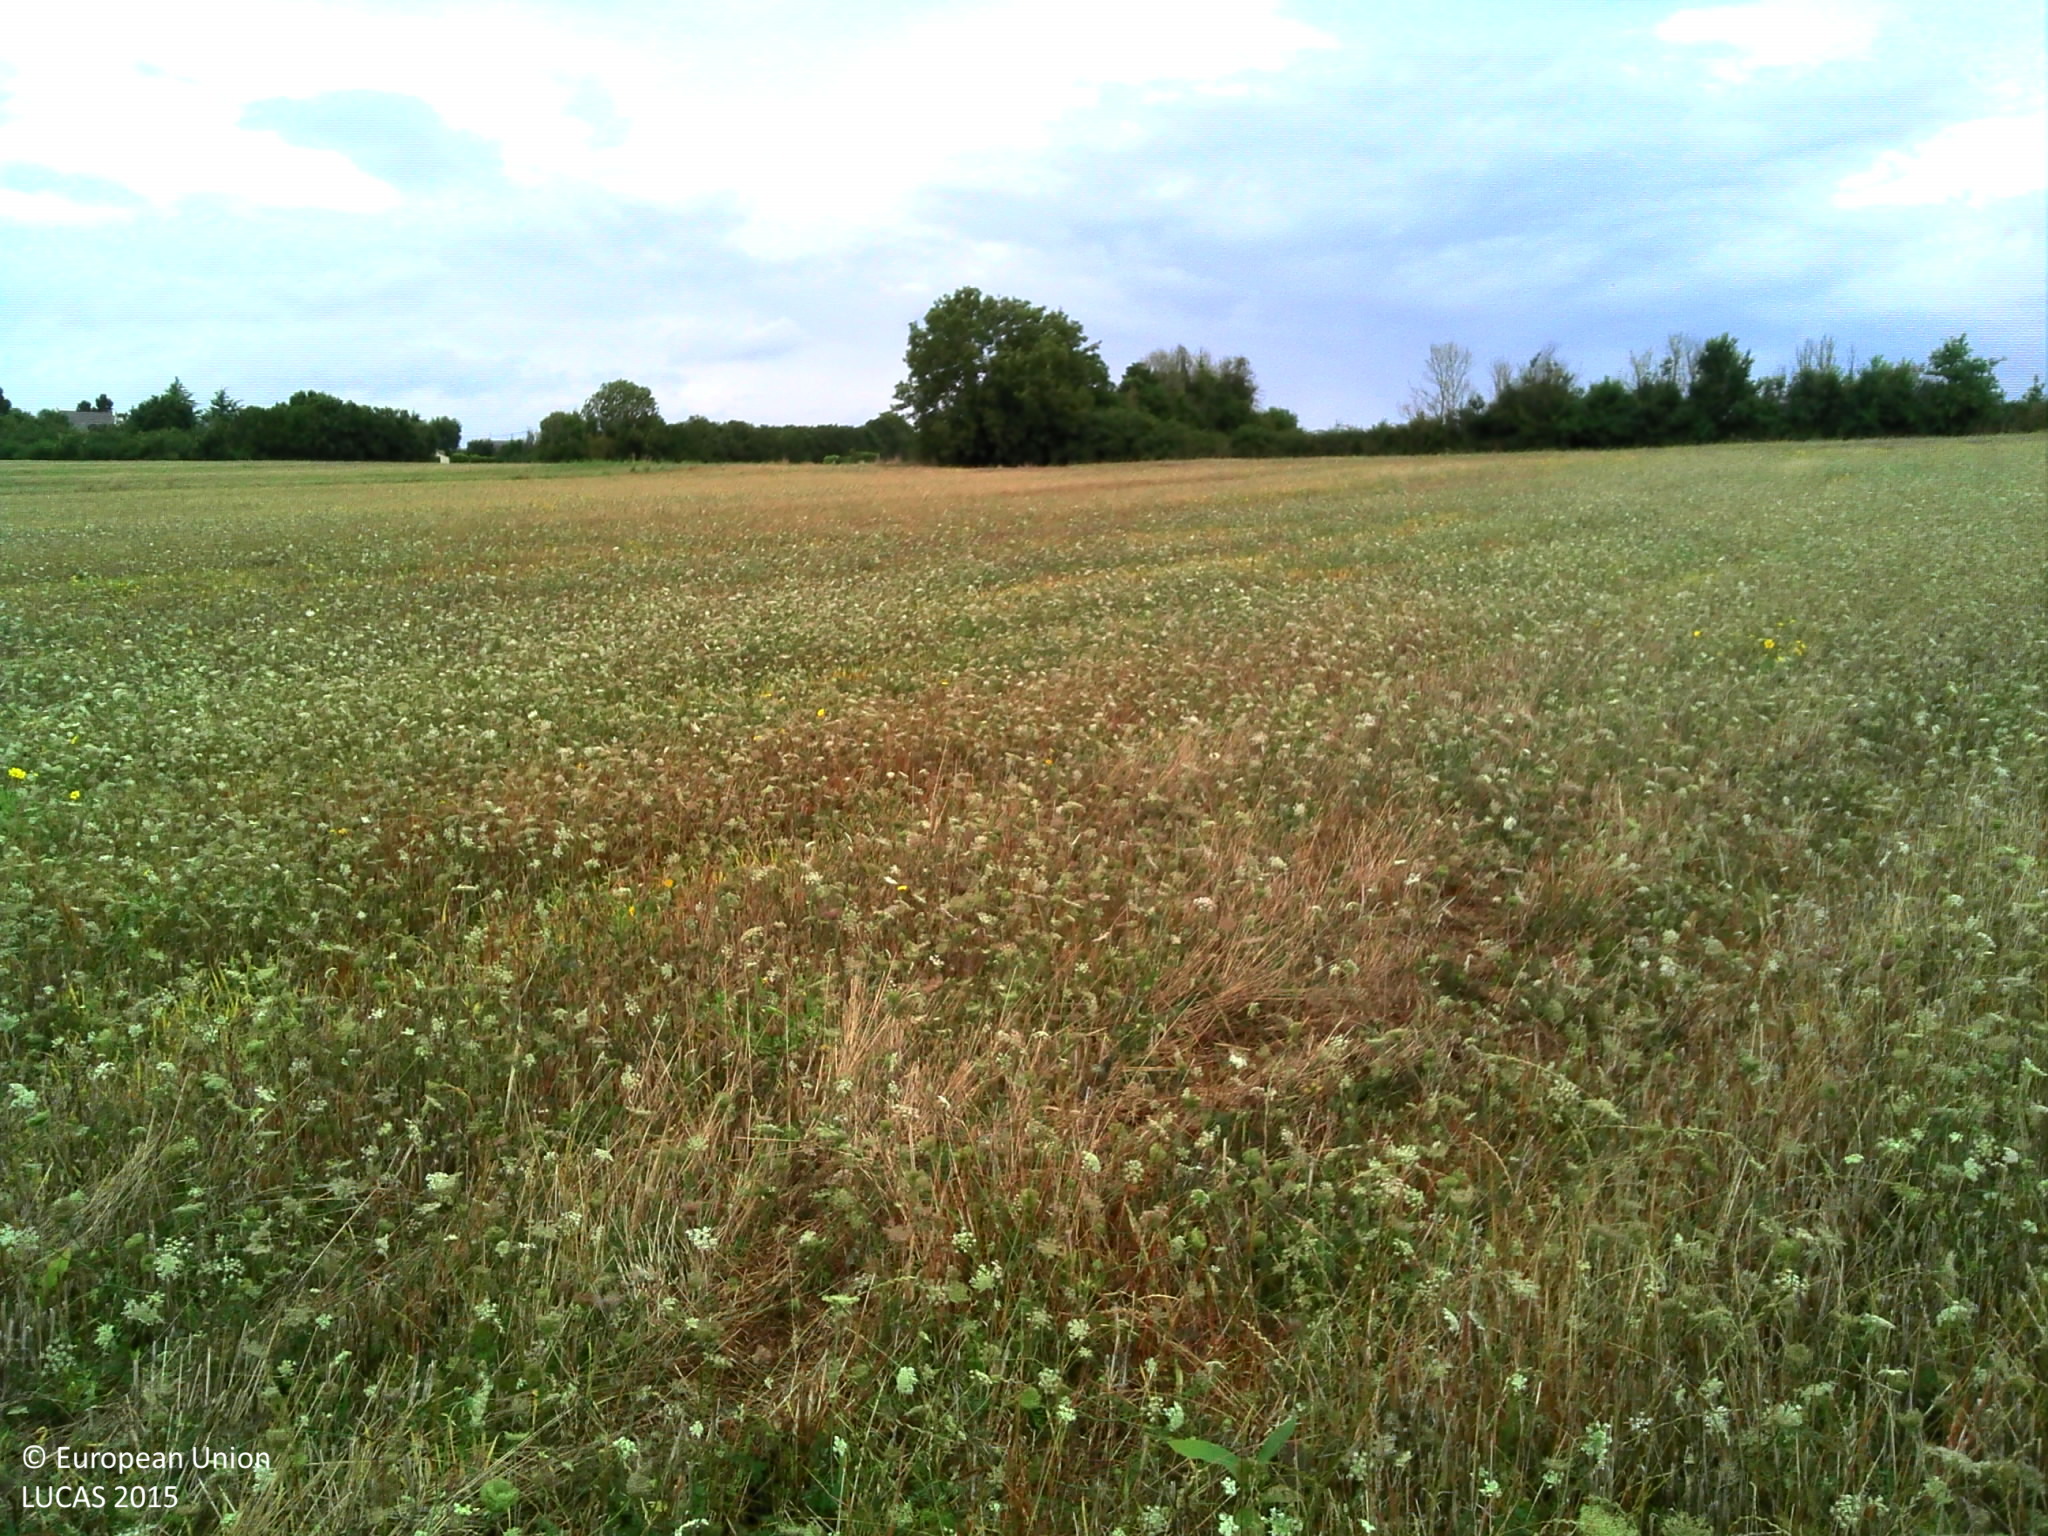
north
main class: Grassland
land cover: Spontaneously vegetated surfaces
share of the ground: > 75 %
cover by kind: herbaceous plants 100 %
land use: Fallow land
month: August
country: FR
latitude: 48.5872
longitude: -2.1356
